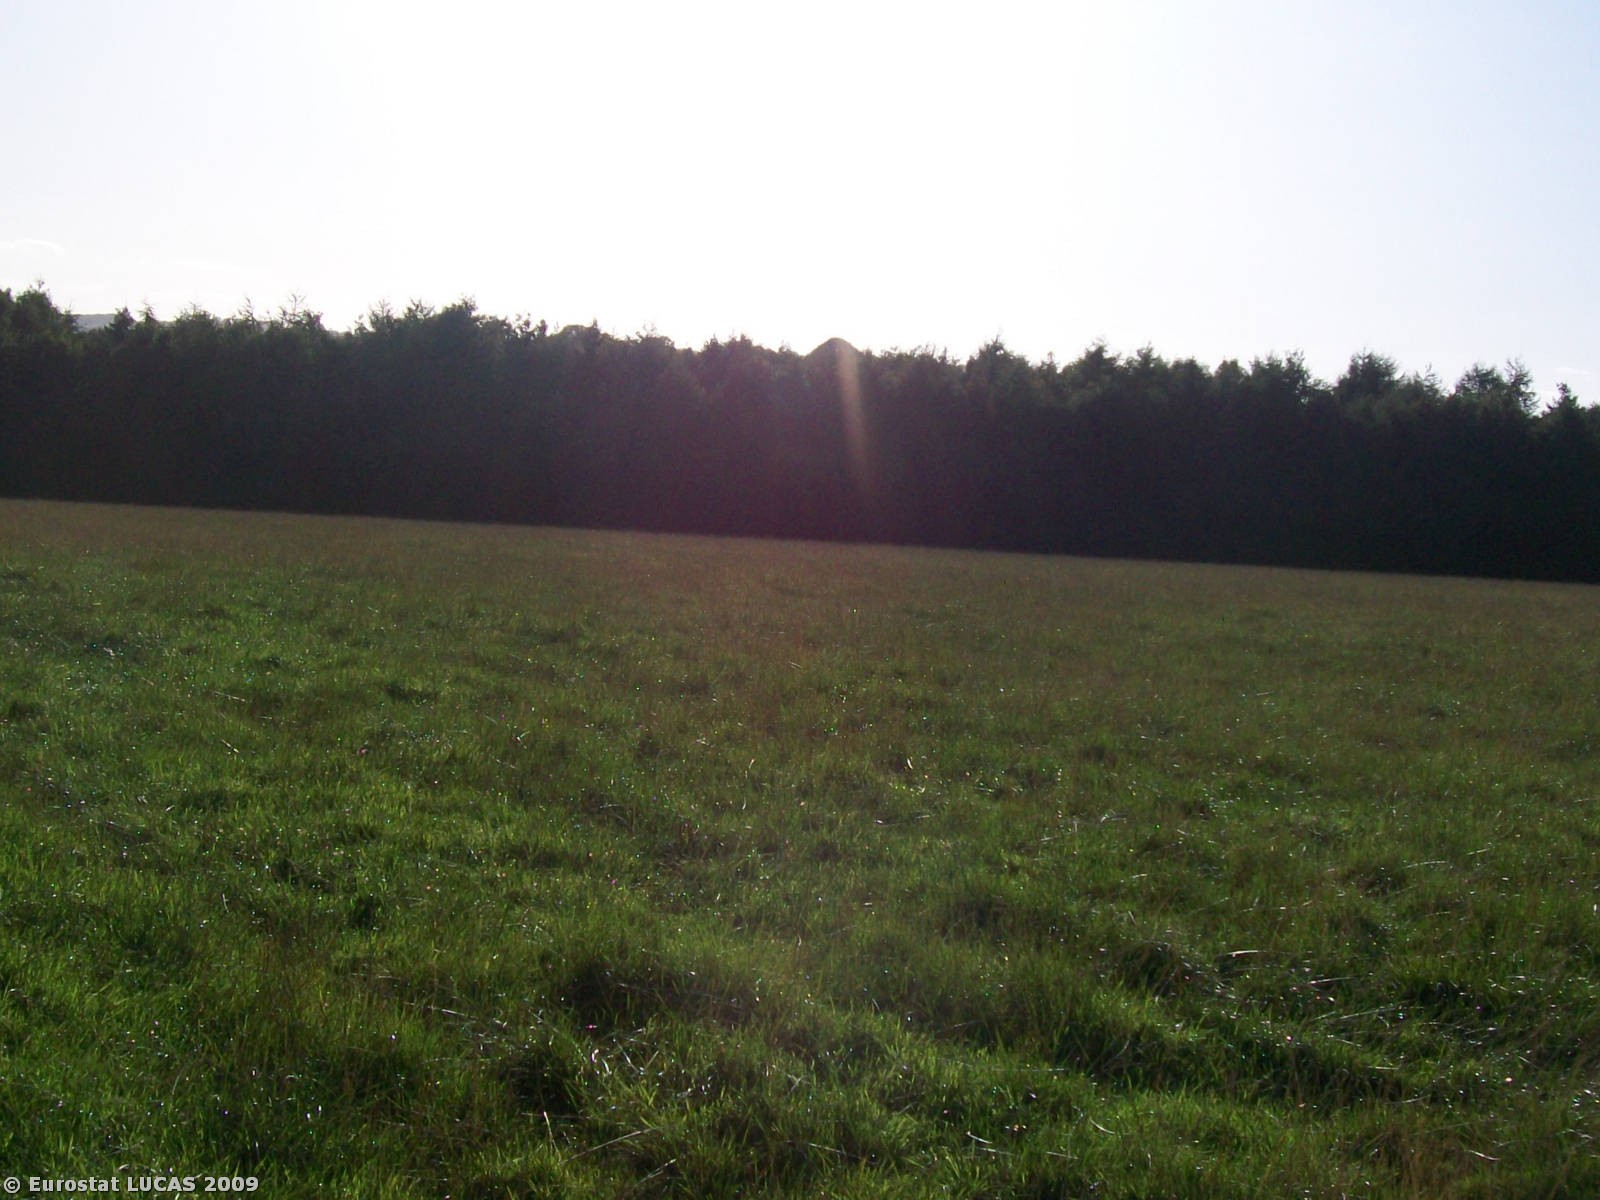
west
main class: Grassland
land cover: Grassland without tree/shrub cover
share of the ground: > 75 %
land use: Agriculture (excluding fallow land and kitchen gardens)
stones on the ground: < 10 %
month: September
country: GB
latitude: 52.5916
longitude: -2.6305
